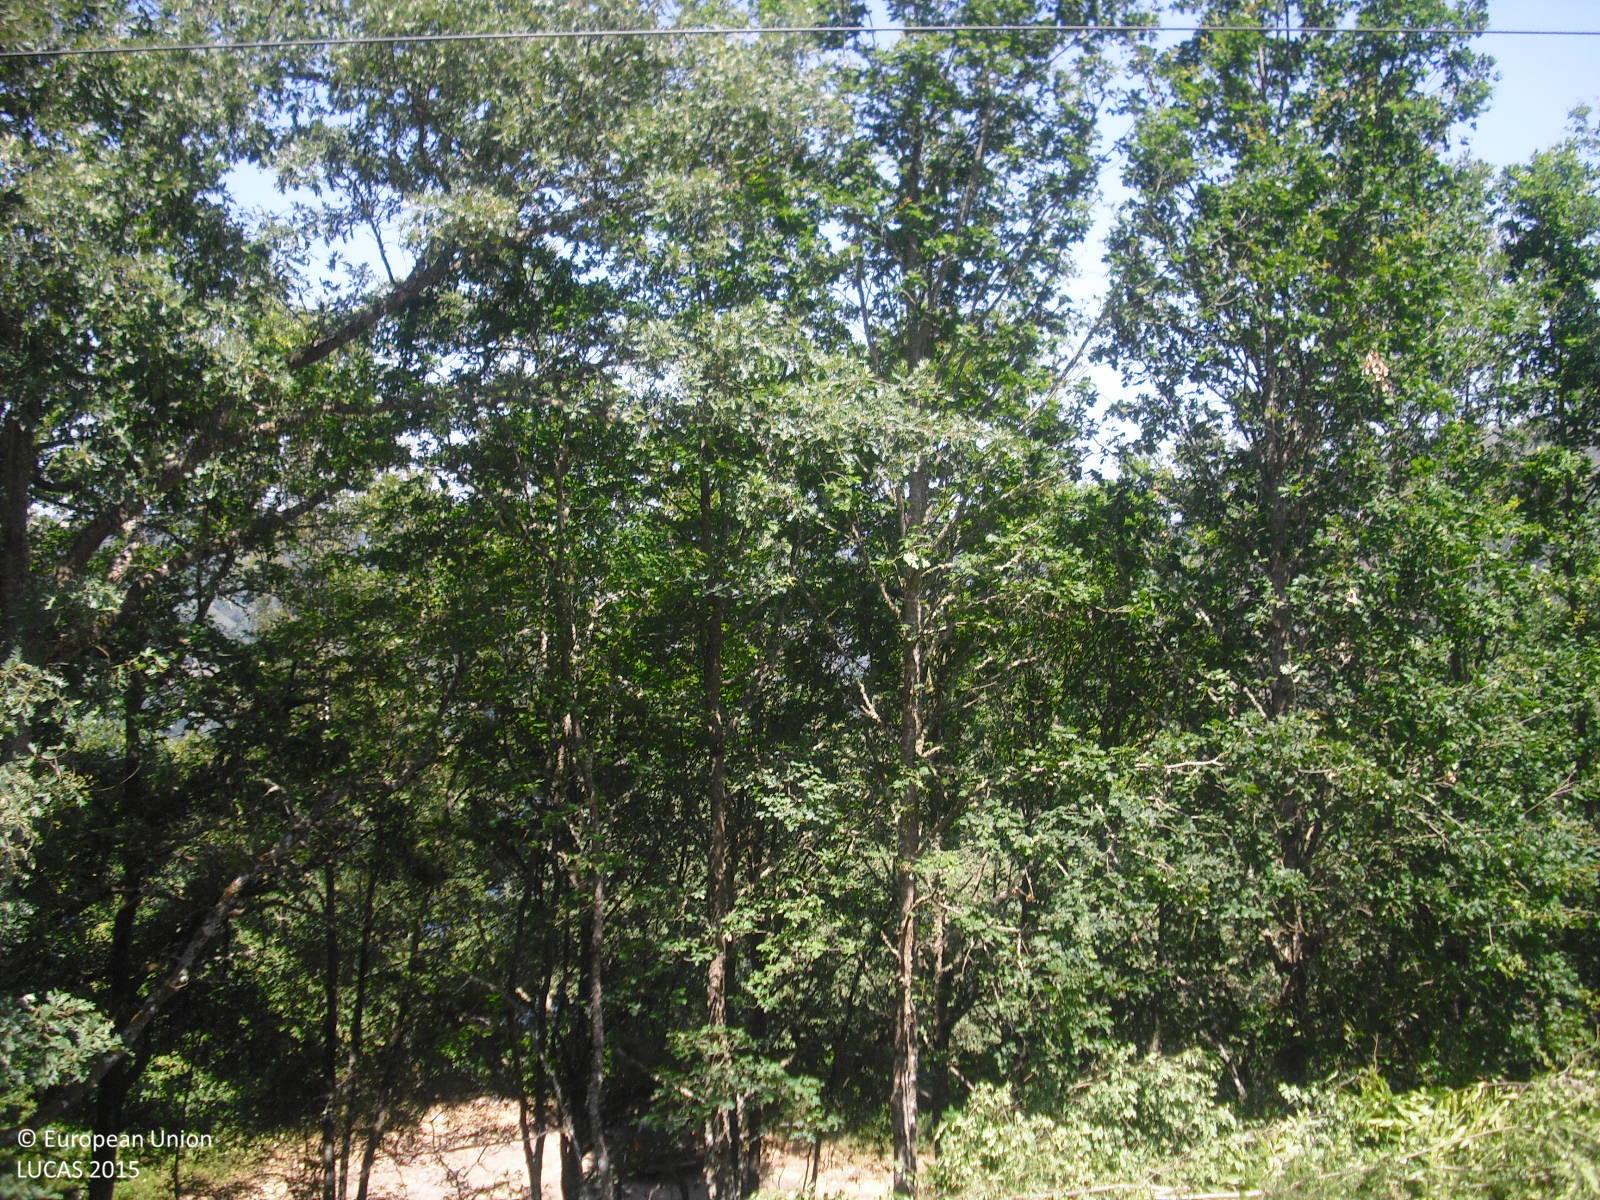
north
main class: Artificial land
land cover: Other artificial areas
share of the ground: < 10 %
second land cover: Shrubland with sparse tree cover
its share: > 75 %
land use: Electricity, gas and thermal power distribution
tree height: < 5 m
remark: Fire break
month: June
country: ES
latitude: 42.6260
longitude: -7.7202
